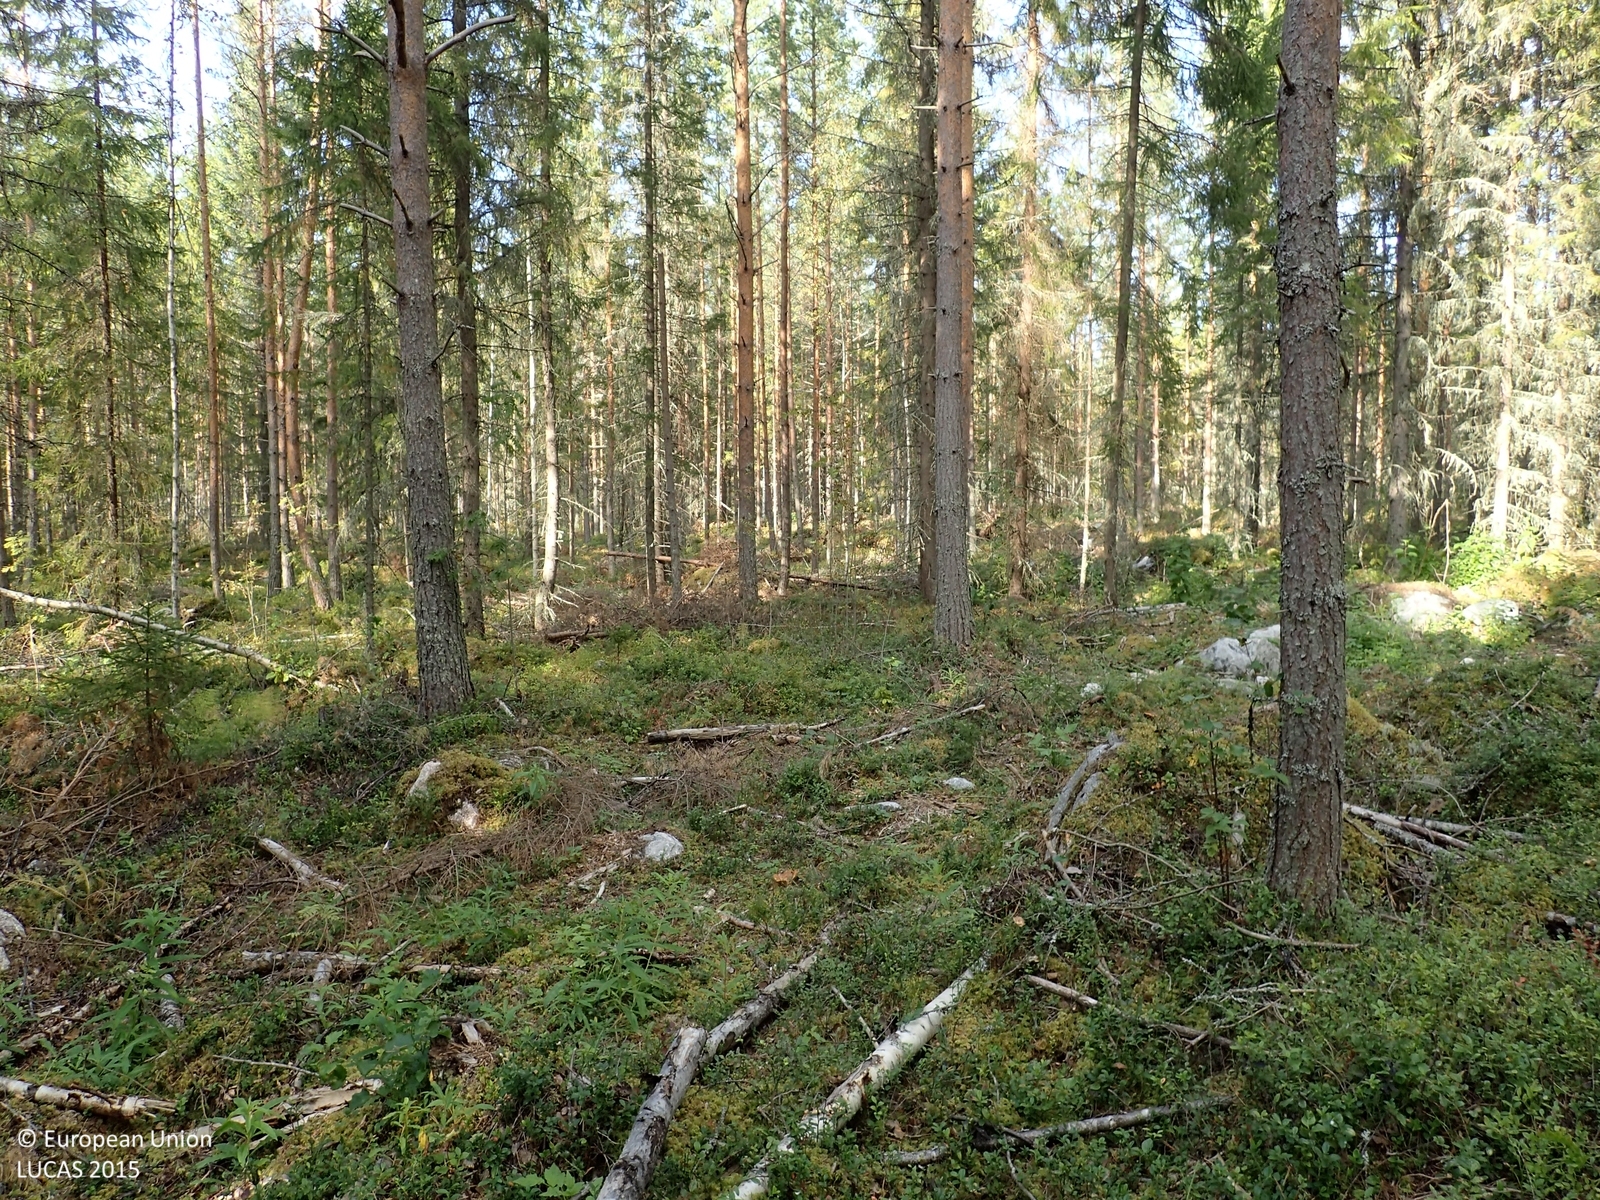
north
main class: Woodland
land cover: Other mixed woodland
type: boreal forest
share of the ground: > 75 %
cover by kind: coniferous forest trees 55 %, broadleaved forest trees 20 %, shrubs 15 %, lichens and mosses 10 %
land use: Forestry
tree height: > 5 m
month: September
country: FI
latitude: 63.0283
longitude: 25.4207
